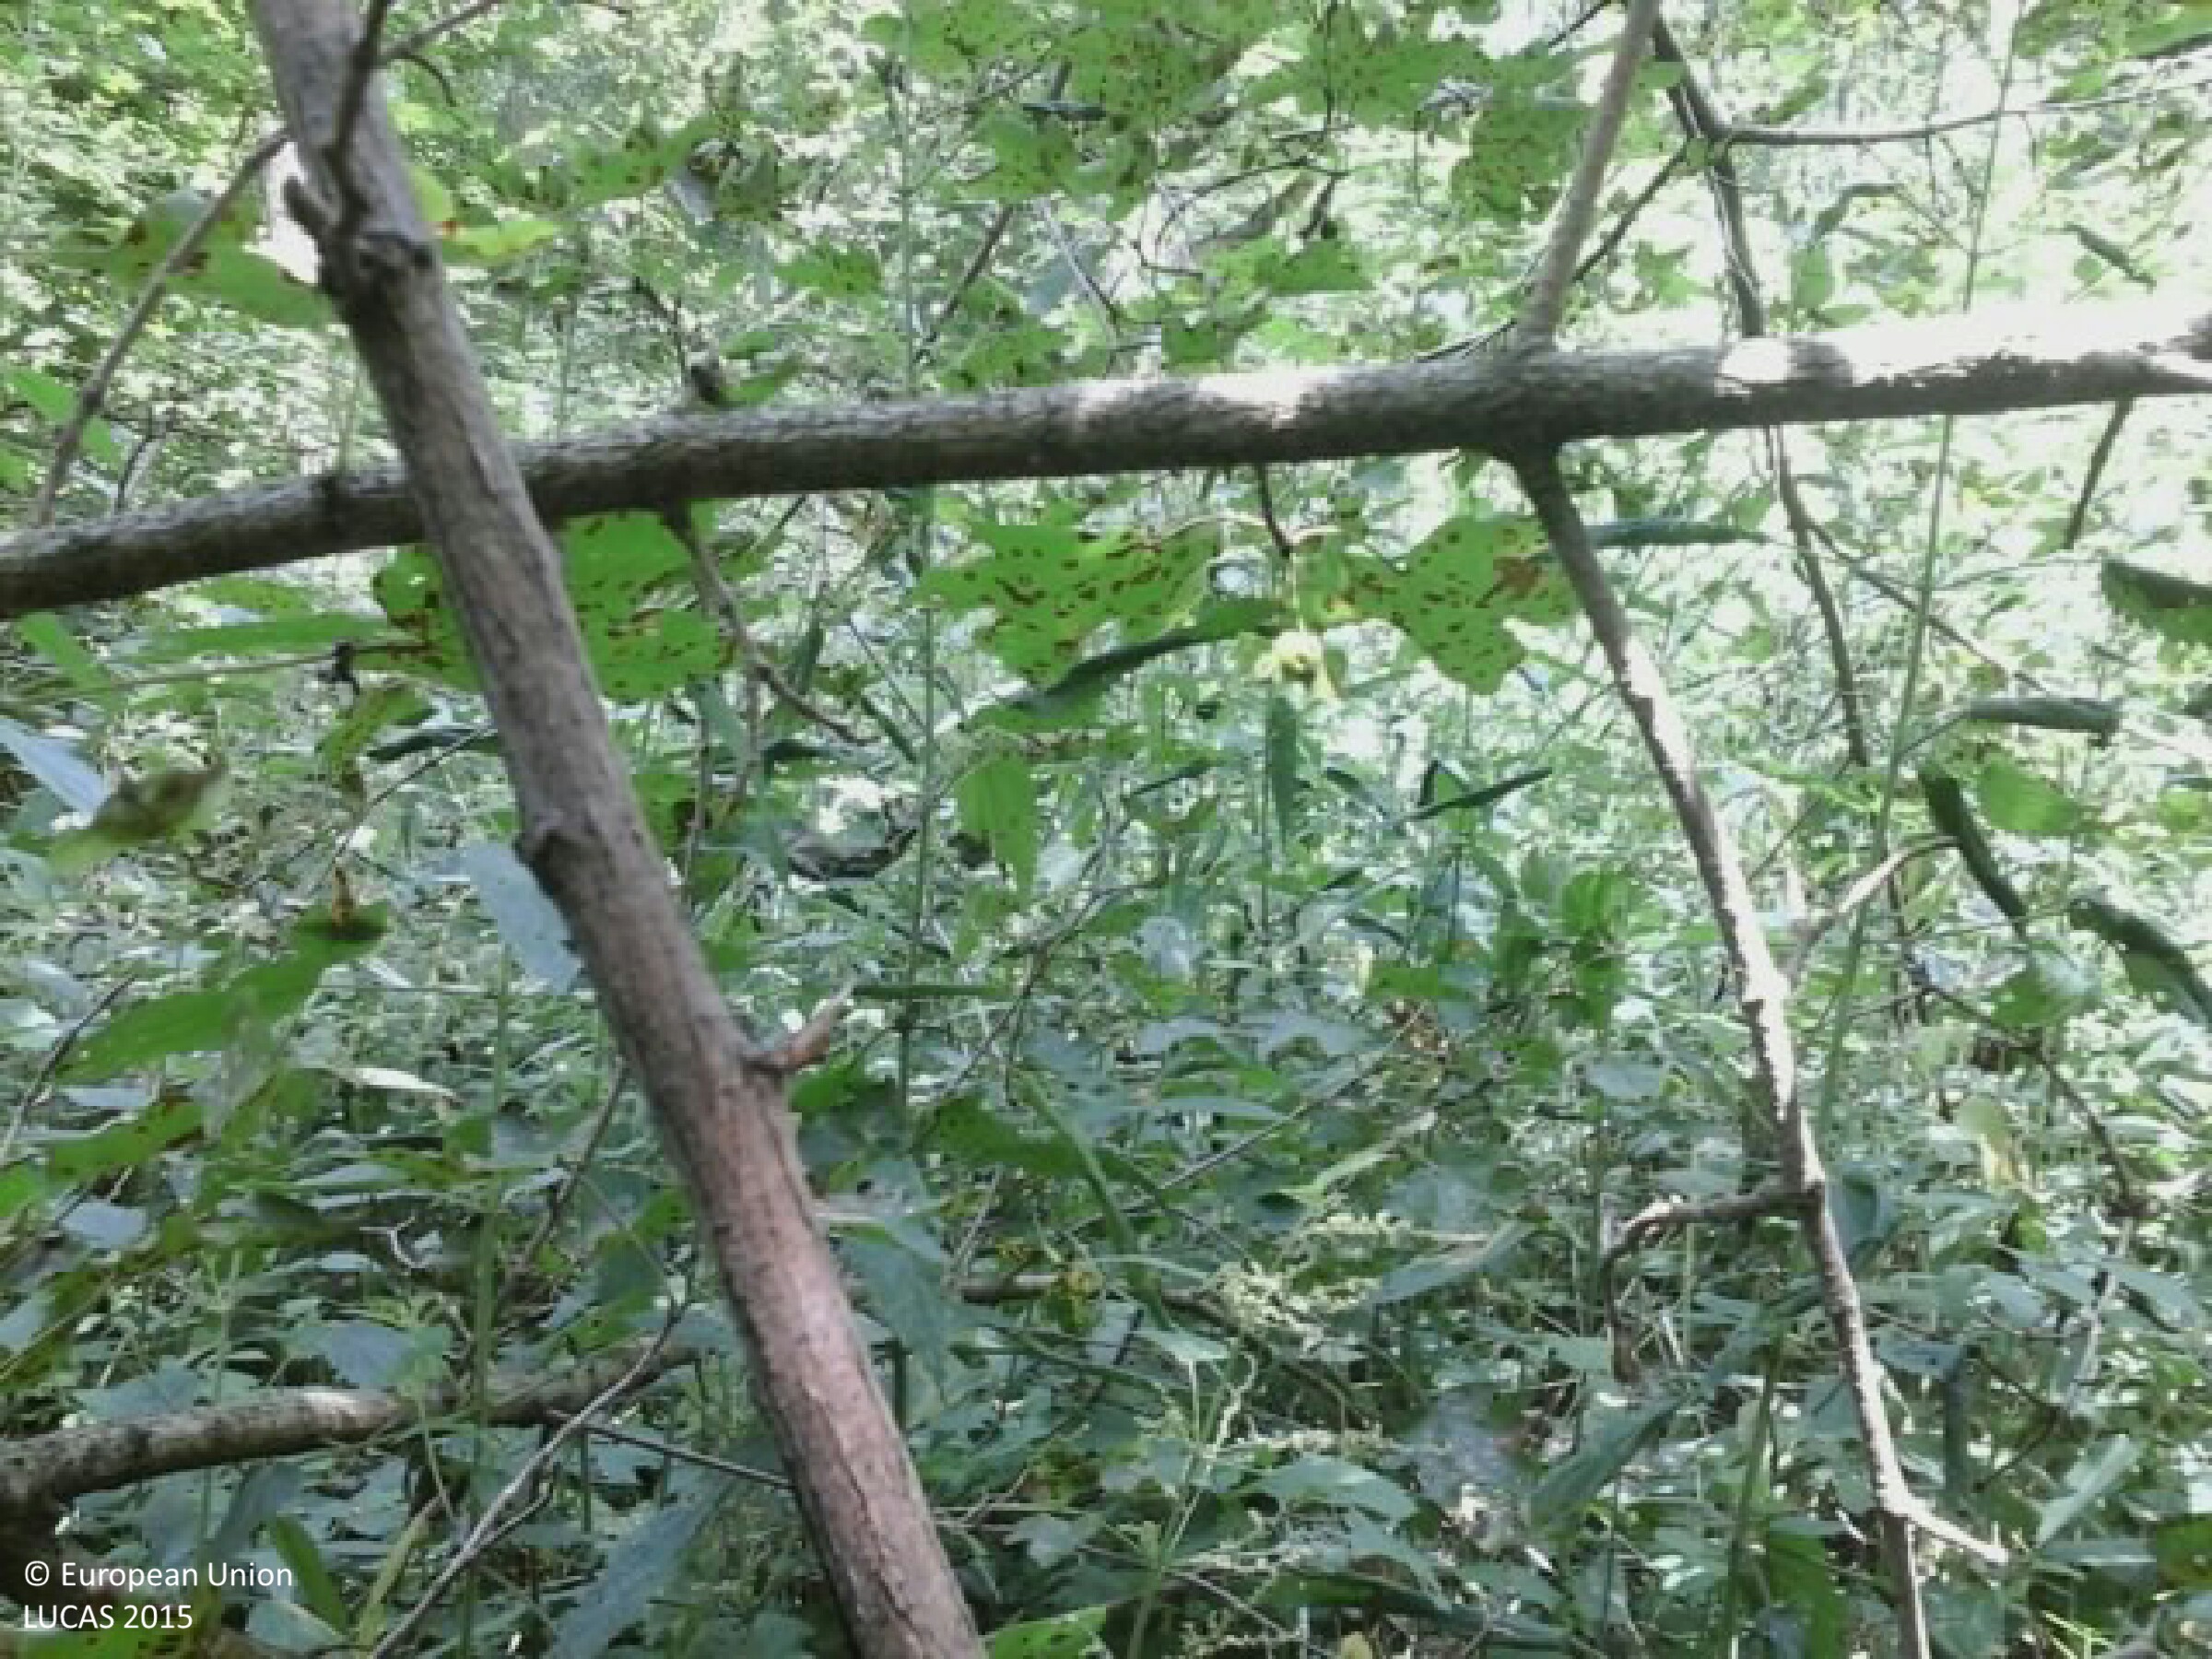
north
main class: Woodland
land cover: Broadleaved woodland
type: mesophytic deciduous forest
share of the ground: > 75 %
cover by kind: broadleaved forest trees 90 %, shrubs 5 %, herbaceous plants 5 %
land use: Forestry
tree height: > 5 m
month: July
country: HU
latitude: 46.3187
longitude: 17.0285
